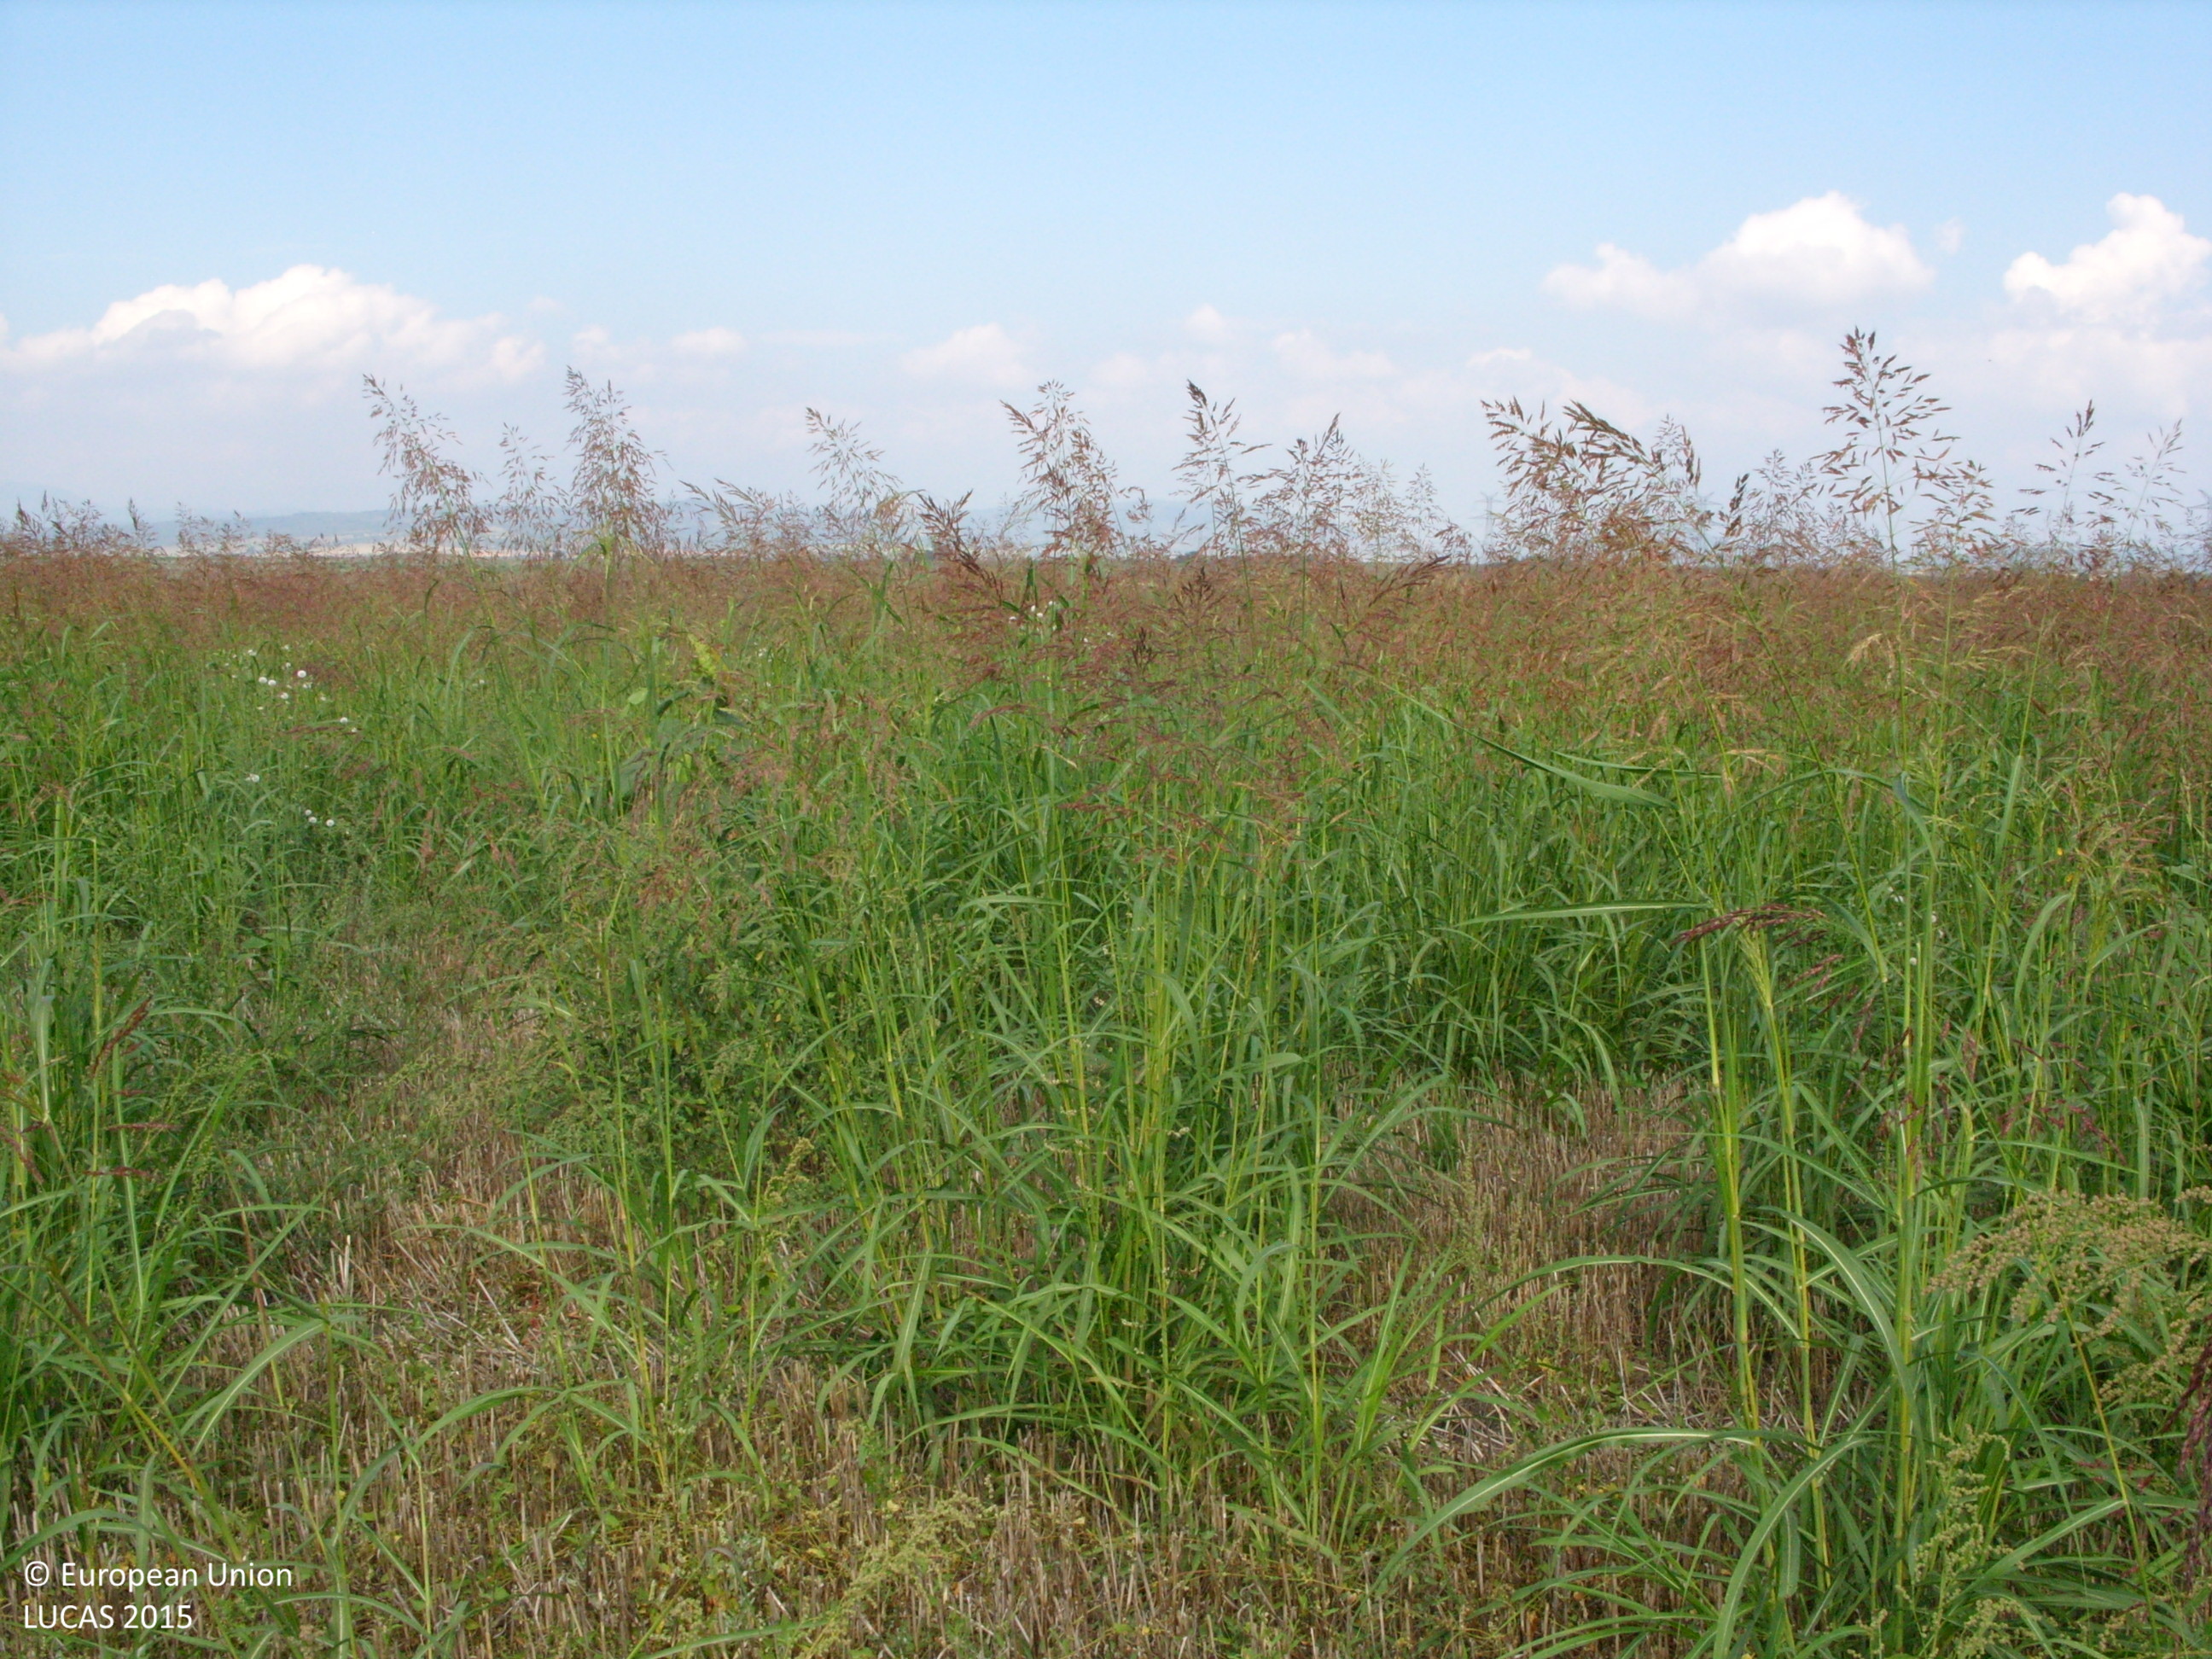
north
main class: Grassland
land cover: Spontaneously vegetated surfaces
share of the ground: > 75 %
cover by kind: herbaceous plants 100 %
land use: Fallow land
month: September
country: BG
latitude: 42.3899
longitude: 24.7648
